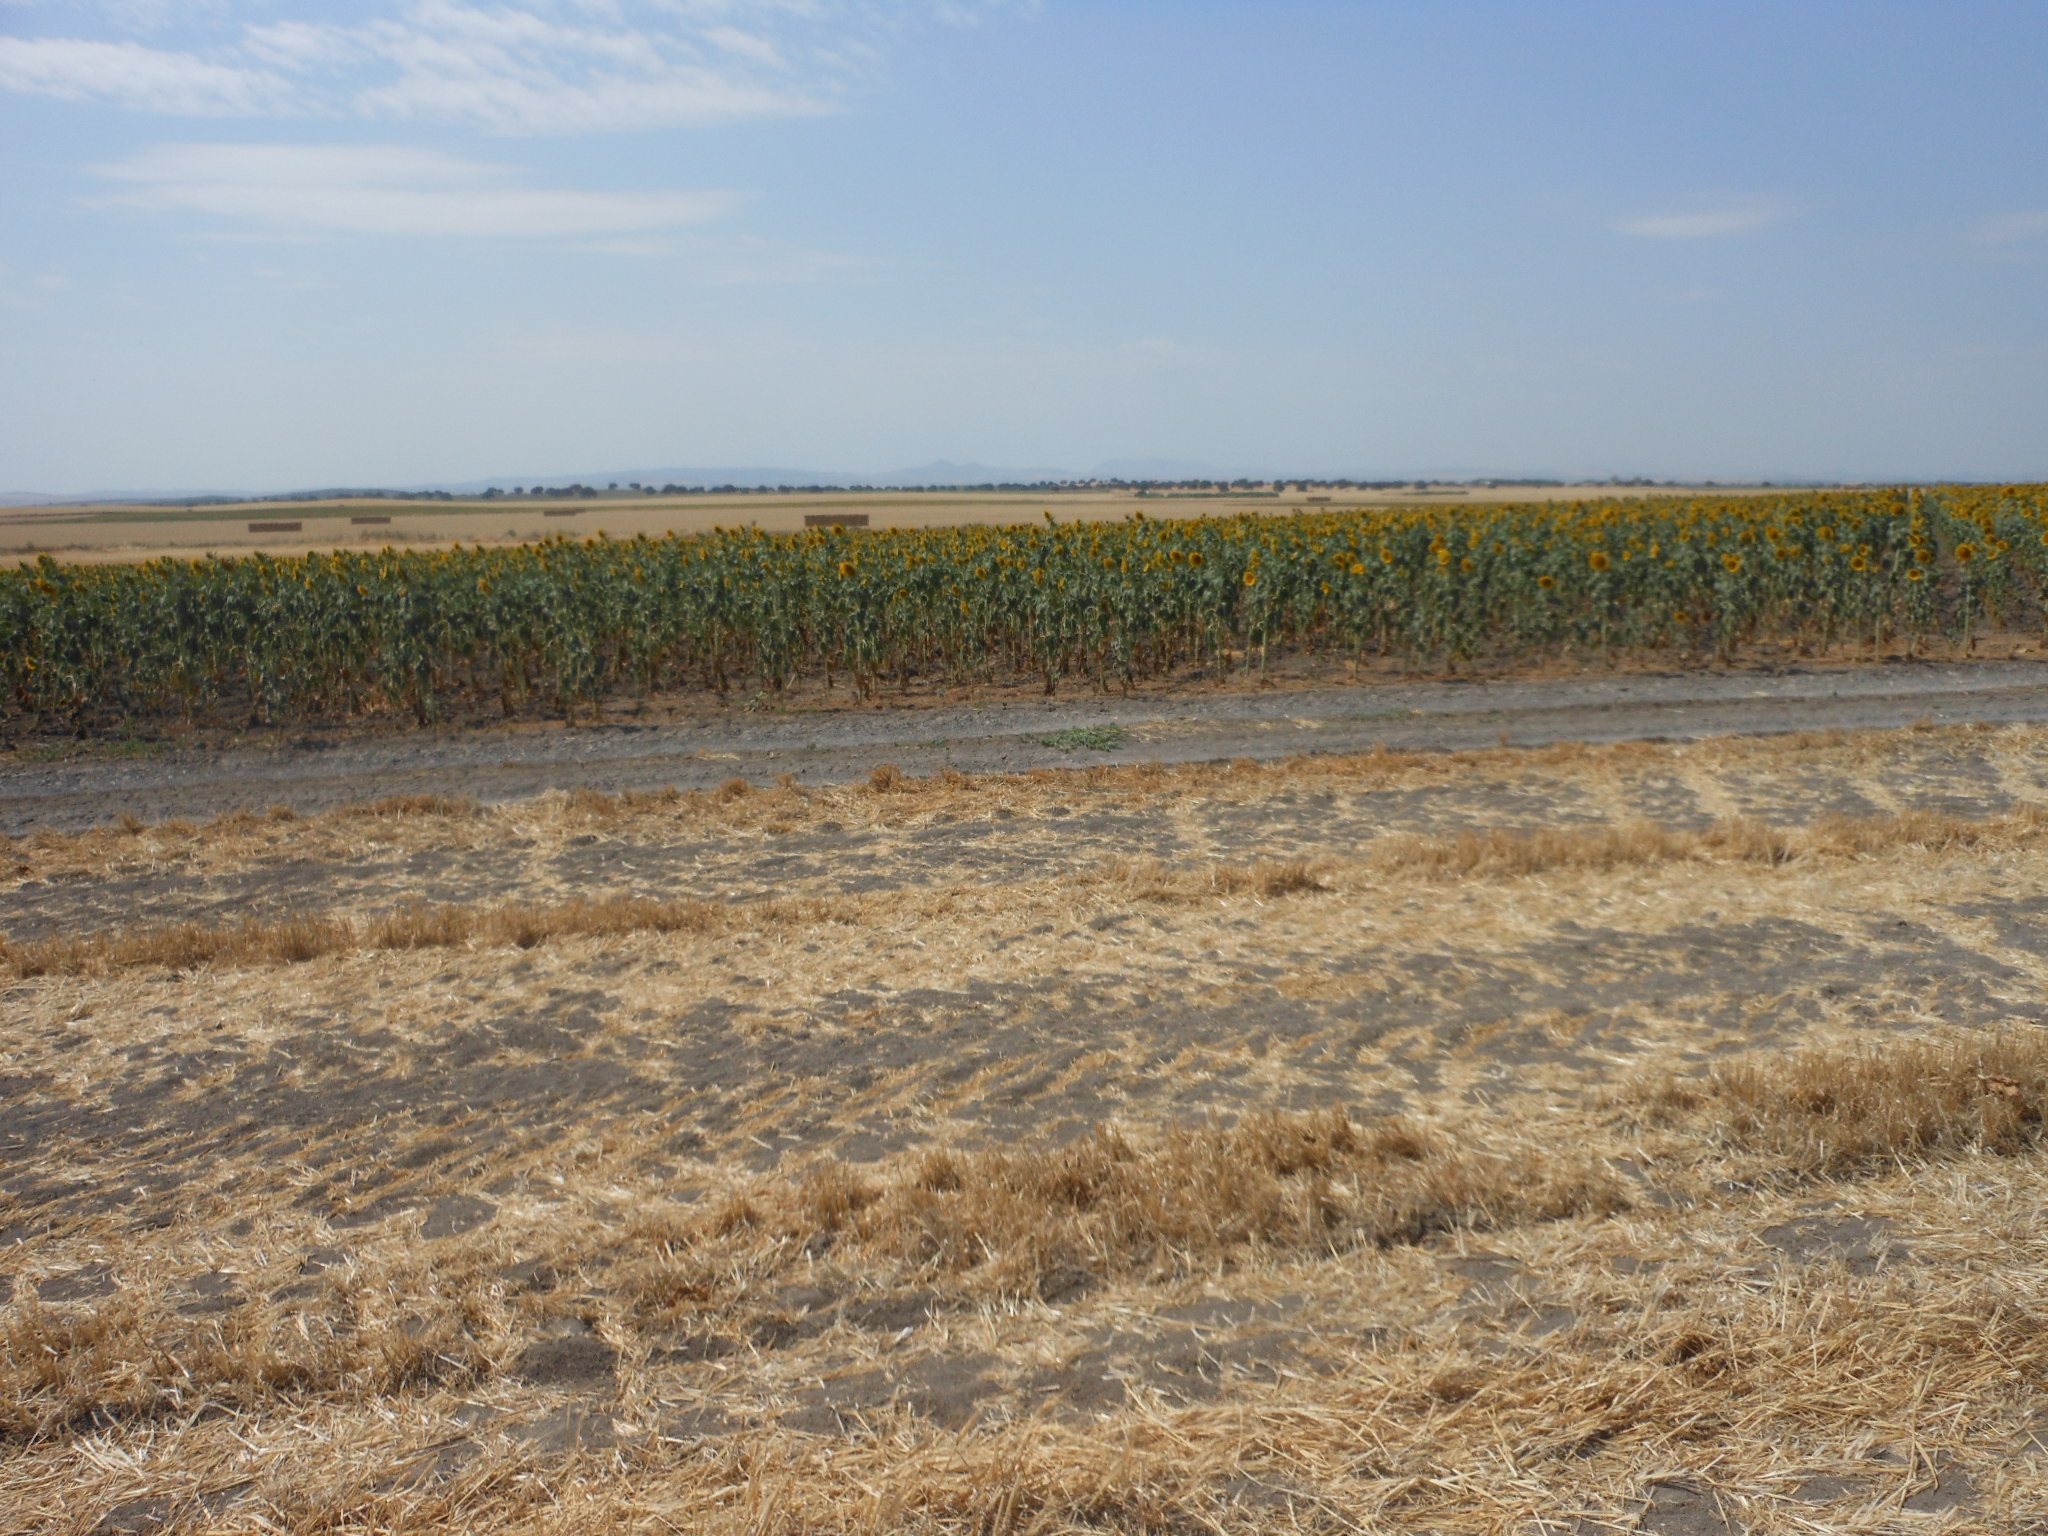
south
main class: Cropland
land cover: Durum wheat
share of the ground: < 10 %
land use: Agriculture (excluding fallow land and kitchen gardens)
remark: Harvested field
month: June
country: ES
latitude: 37.3937
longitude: -5.1355
